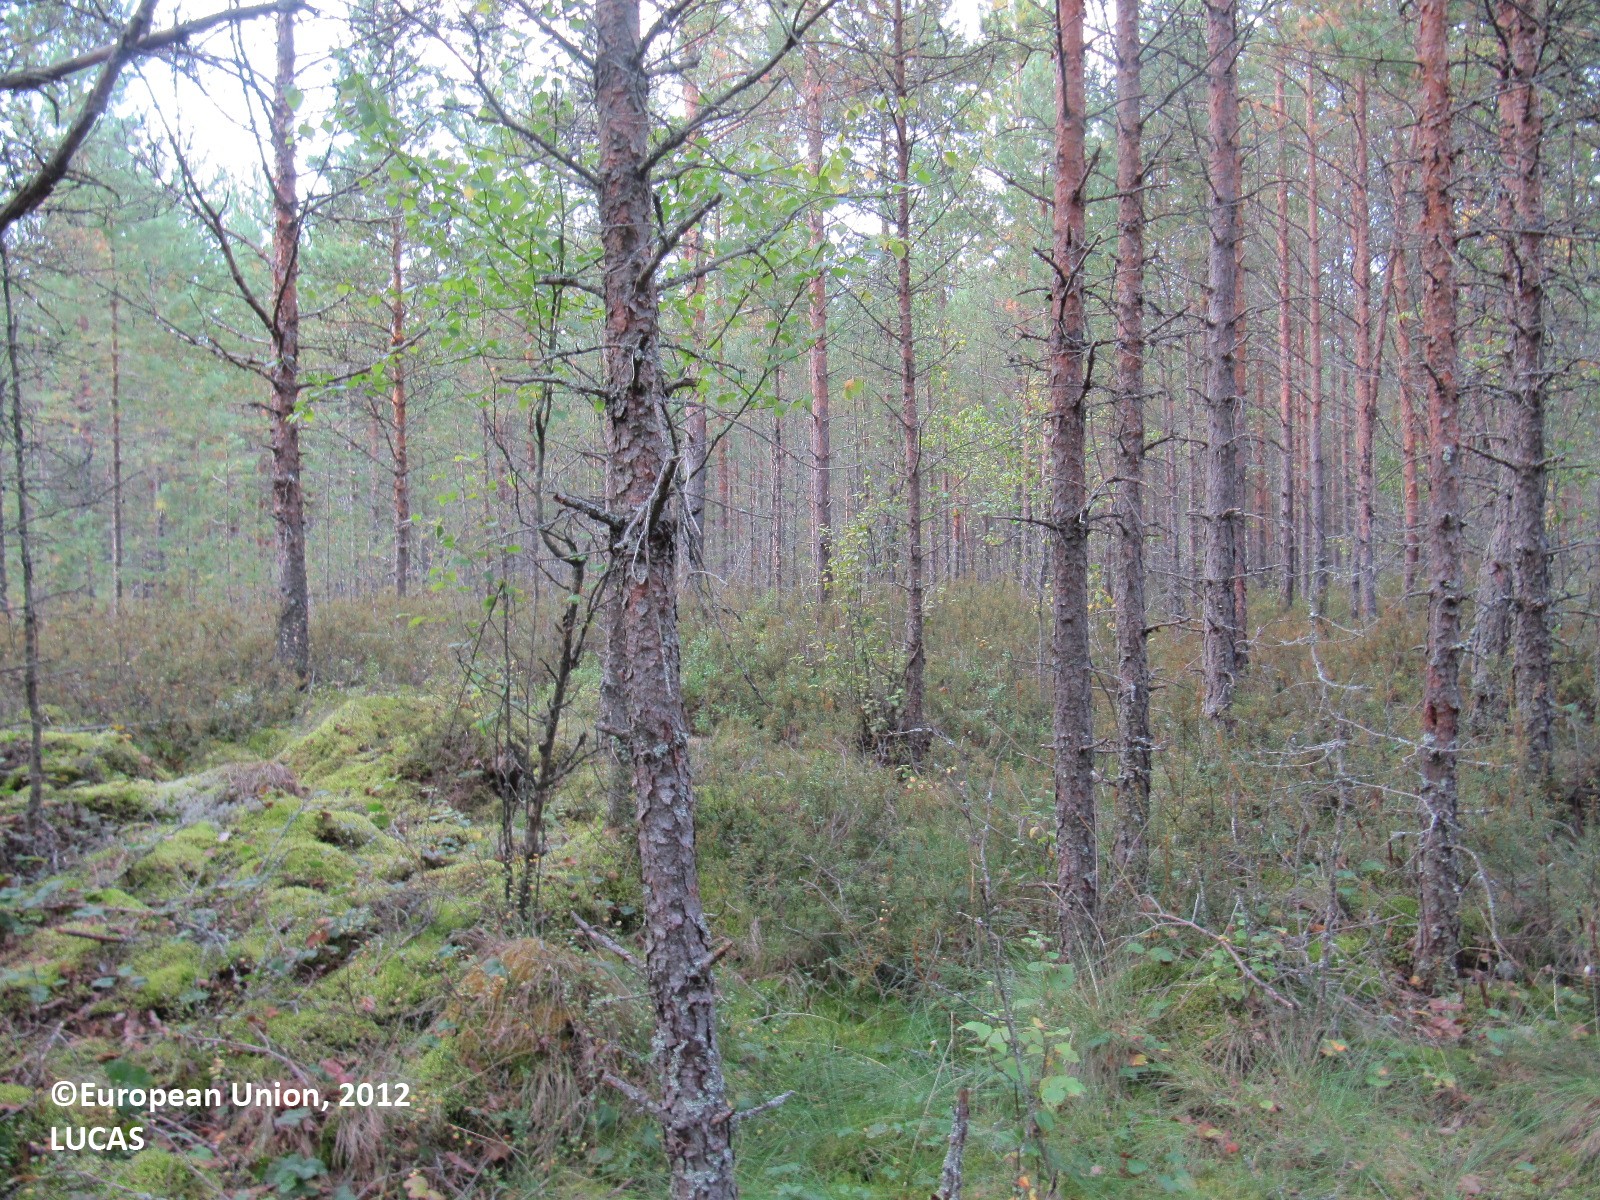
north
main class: Woodland
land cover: Pine dominated coniferous woodland
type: boreal forest
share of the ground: > 75 %
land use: Forestry
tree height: > 5 m
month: August
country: FI
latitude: 61.0617
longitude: 22.9495
